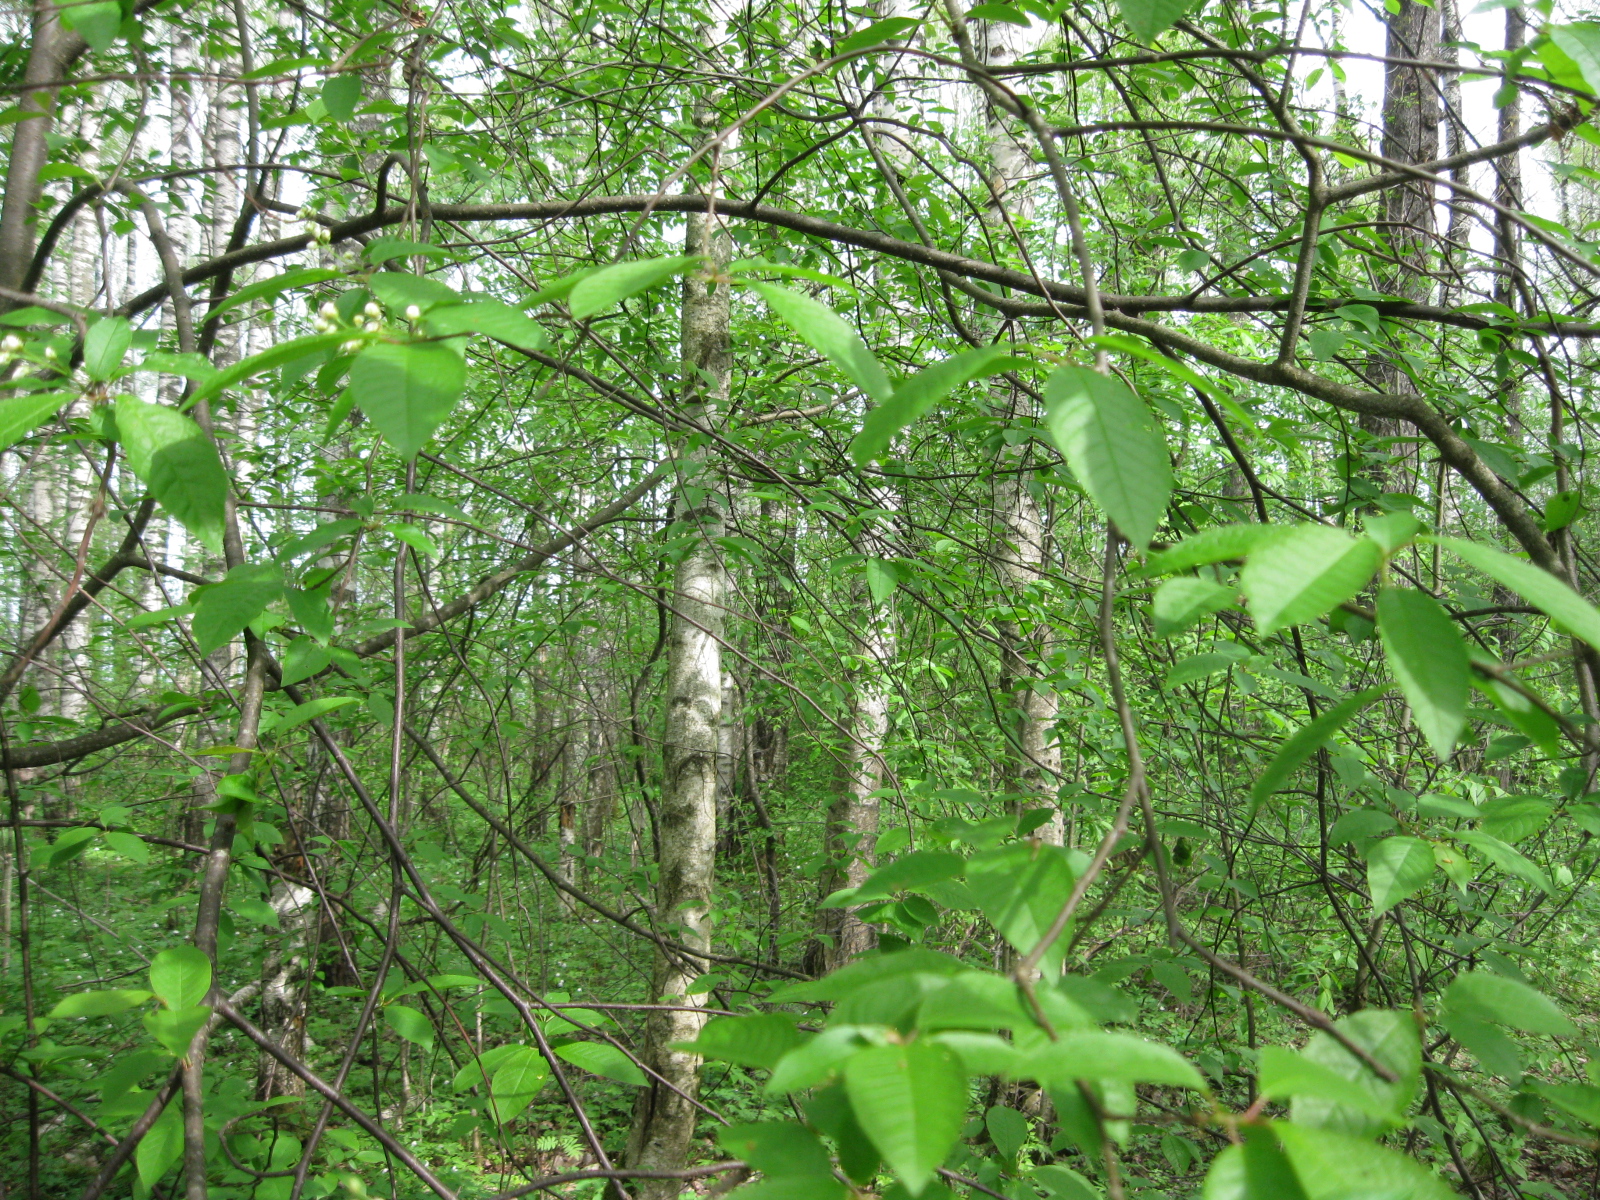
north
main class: Woodland
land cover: Broadleaved woodland
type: non-riverine alder, birch or aspen forest
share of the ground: > 75 %
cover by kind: broadleaved forest trees 85 %, herbaceous plants 10 %, shrubs 5 %
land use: Forestry
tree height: > 5 m
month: May
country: LT
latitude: 56.2536
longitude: 24.5110
